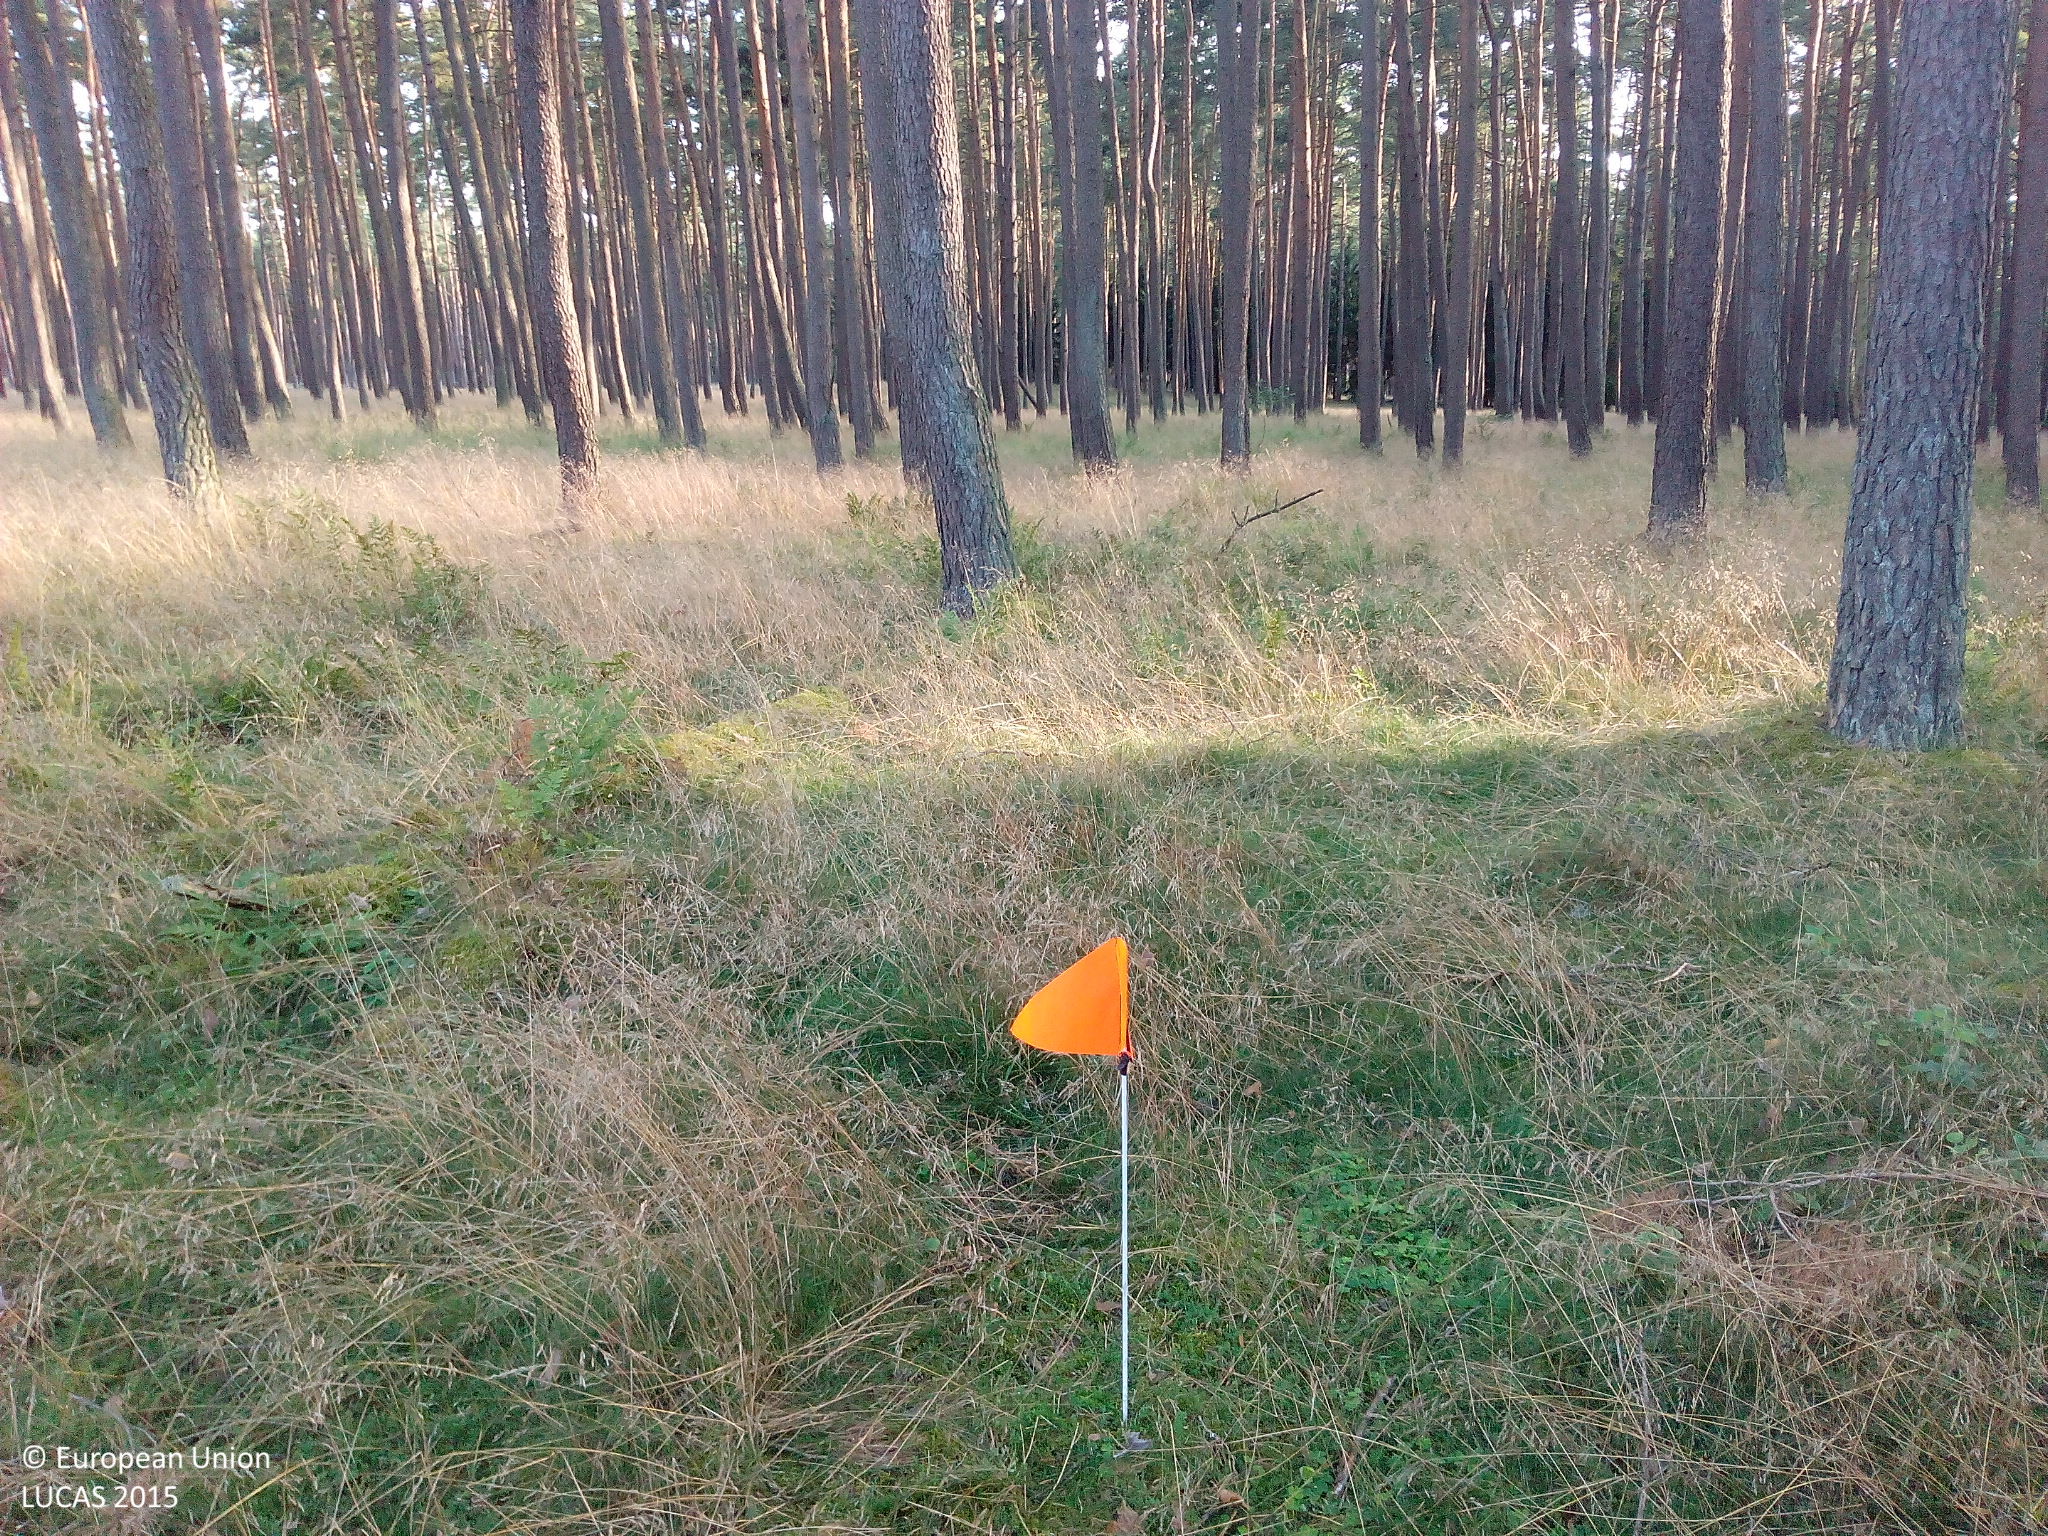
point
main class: Woodland
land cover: Pine dominated coniferous woodland
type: hemiboreal forest and nemoral coniferous forest and mixed broadleaved-coniferous forest
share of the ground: > 75 %
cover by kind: coniferous forest trees 75 %, herbaceous plants 25 %
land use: Forestry
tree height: > 5 m
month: August
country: DE
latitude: 53.5586
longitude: 12.3694
